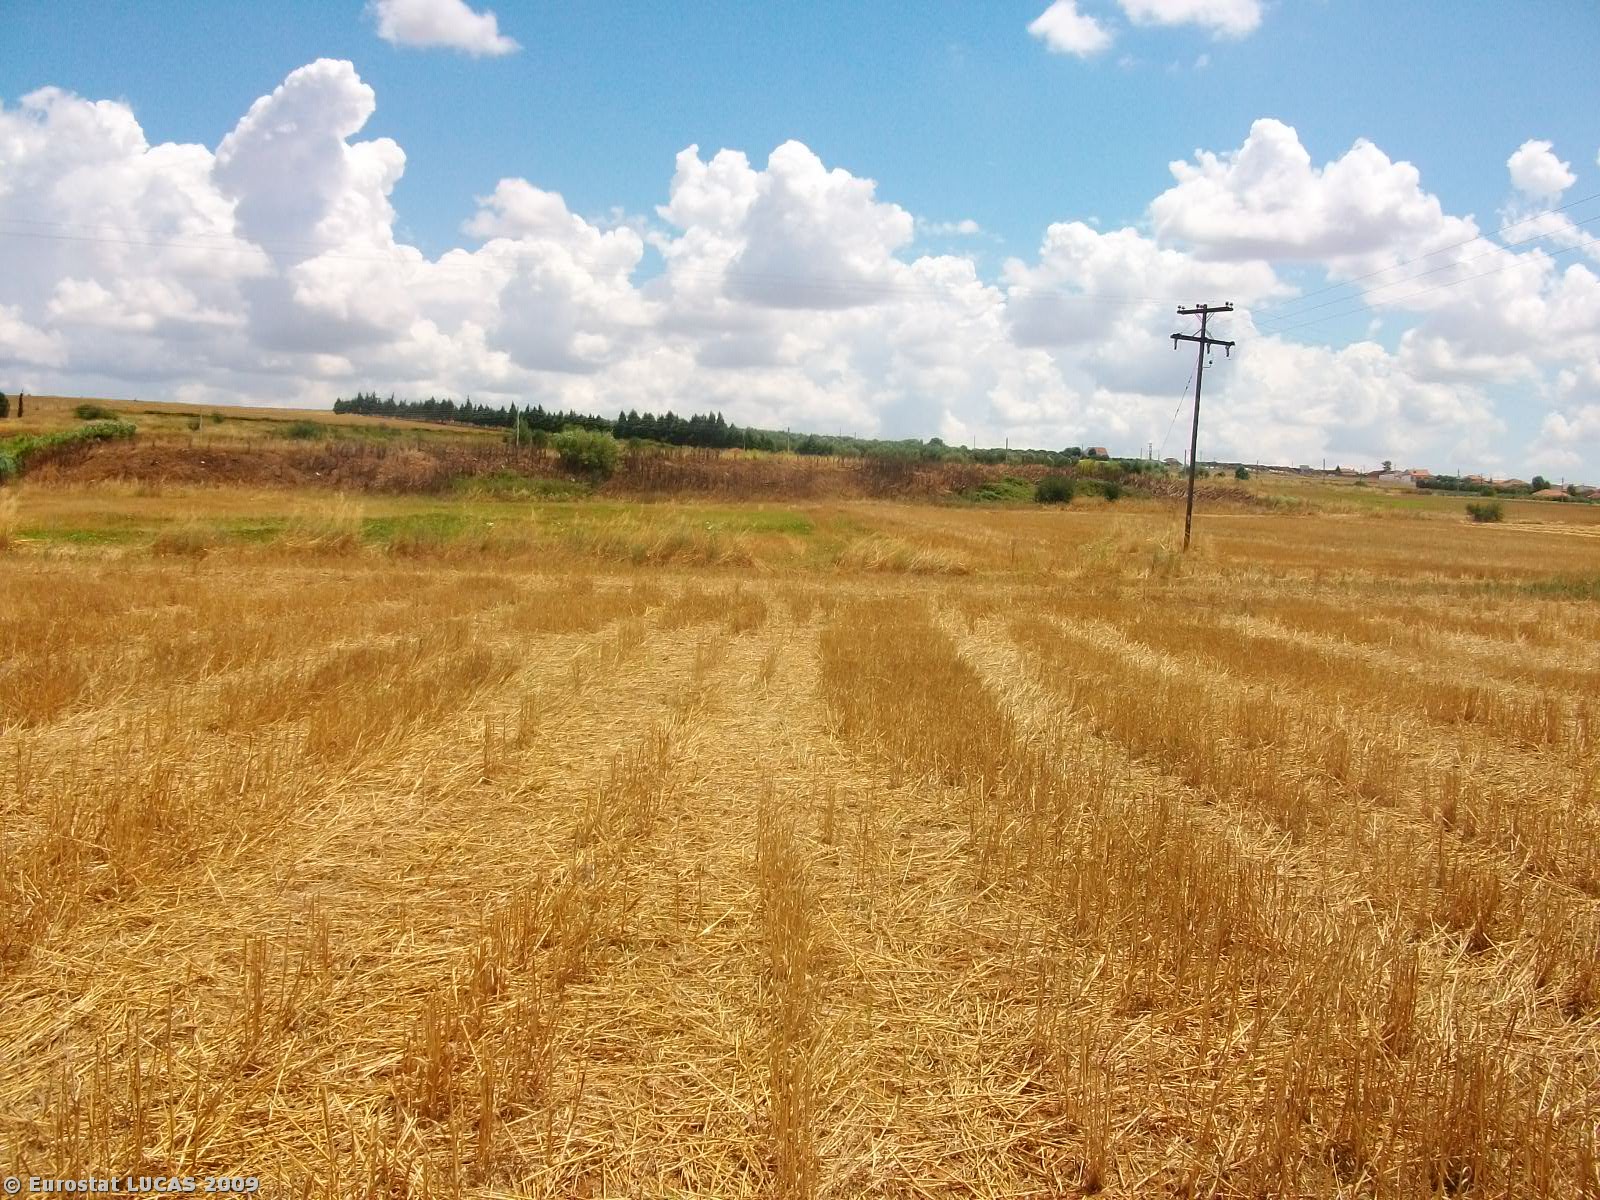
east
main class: Cropland
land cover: Barley
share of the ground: < 10 %
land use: Agriculture (excluding fallow land and kitchen gardens)
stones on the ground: < 10 %
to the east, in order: Barley; Grass margins; Electric lines; Barley; Grassland with sparse tree/shrub cover; Tracks; Grassland without tree/shrub cover; Paved roads, cycling and walking lanes; Grass margins; Tracks
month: June
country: GR
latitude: 40.9132
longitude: 22.7477
